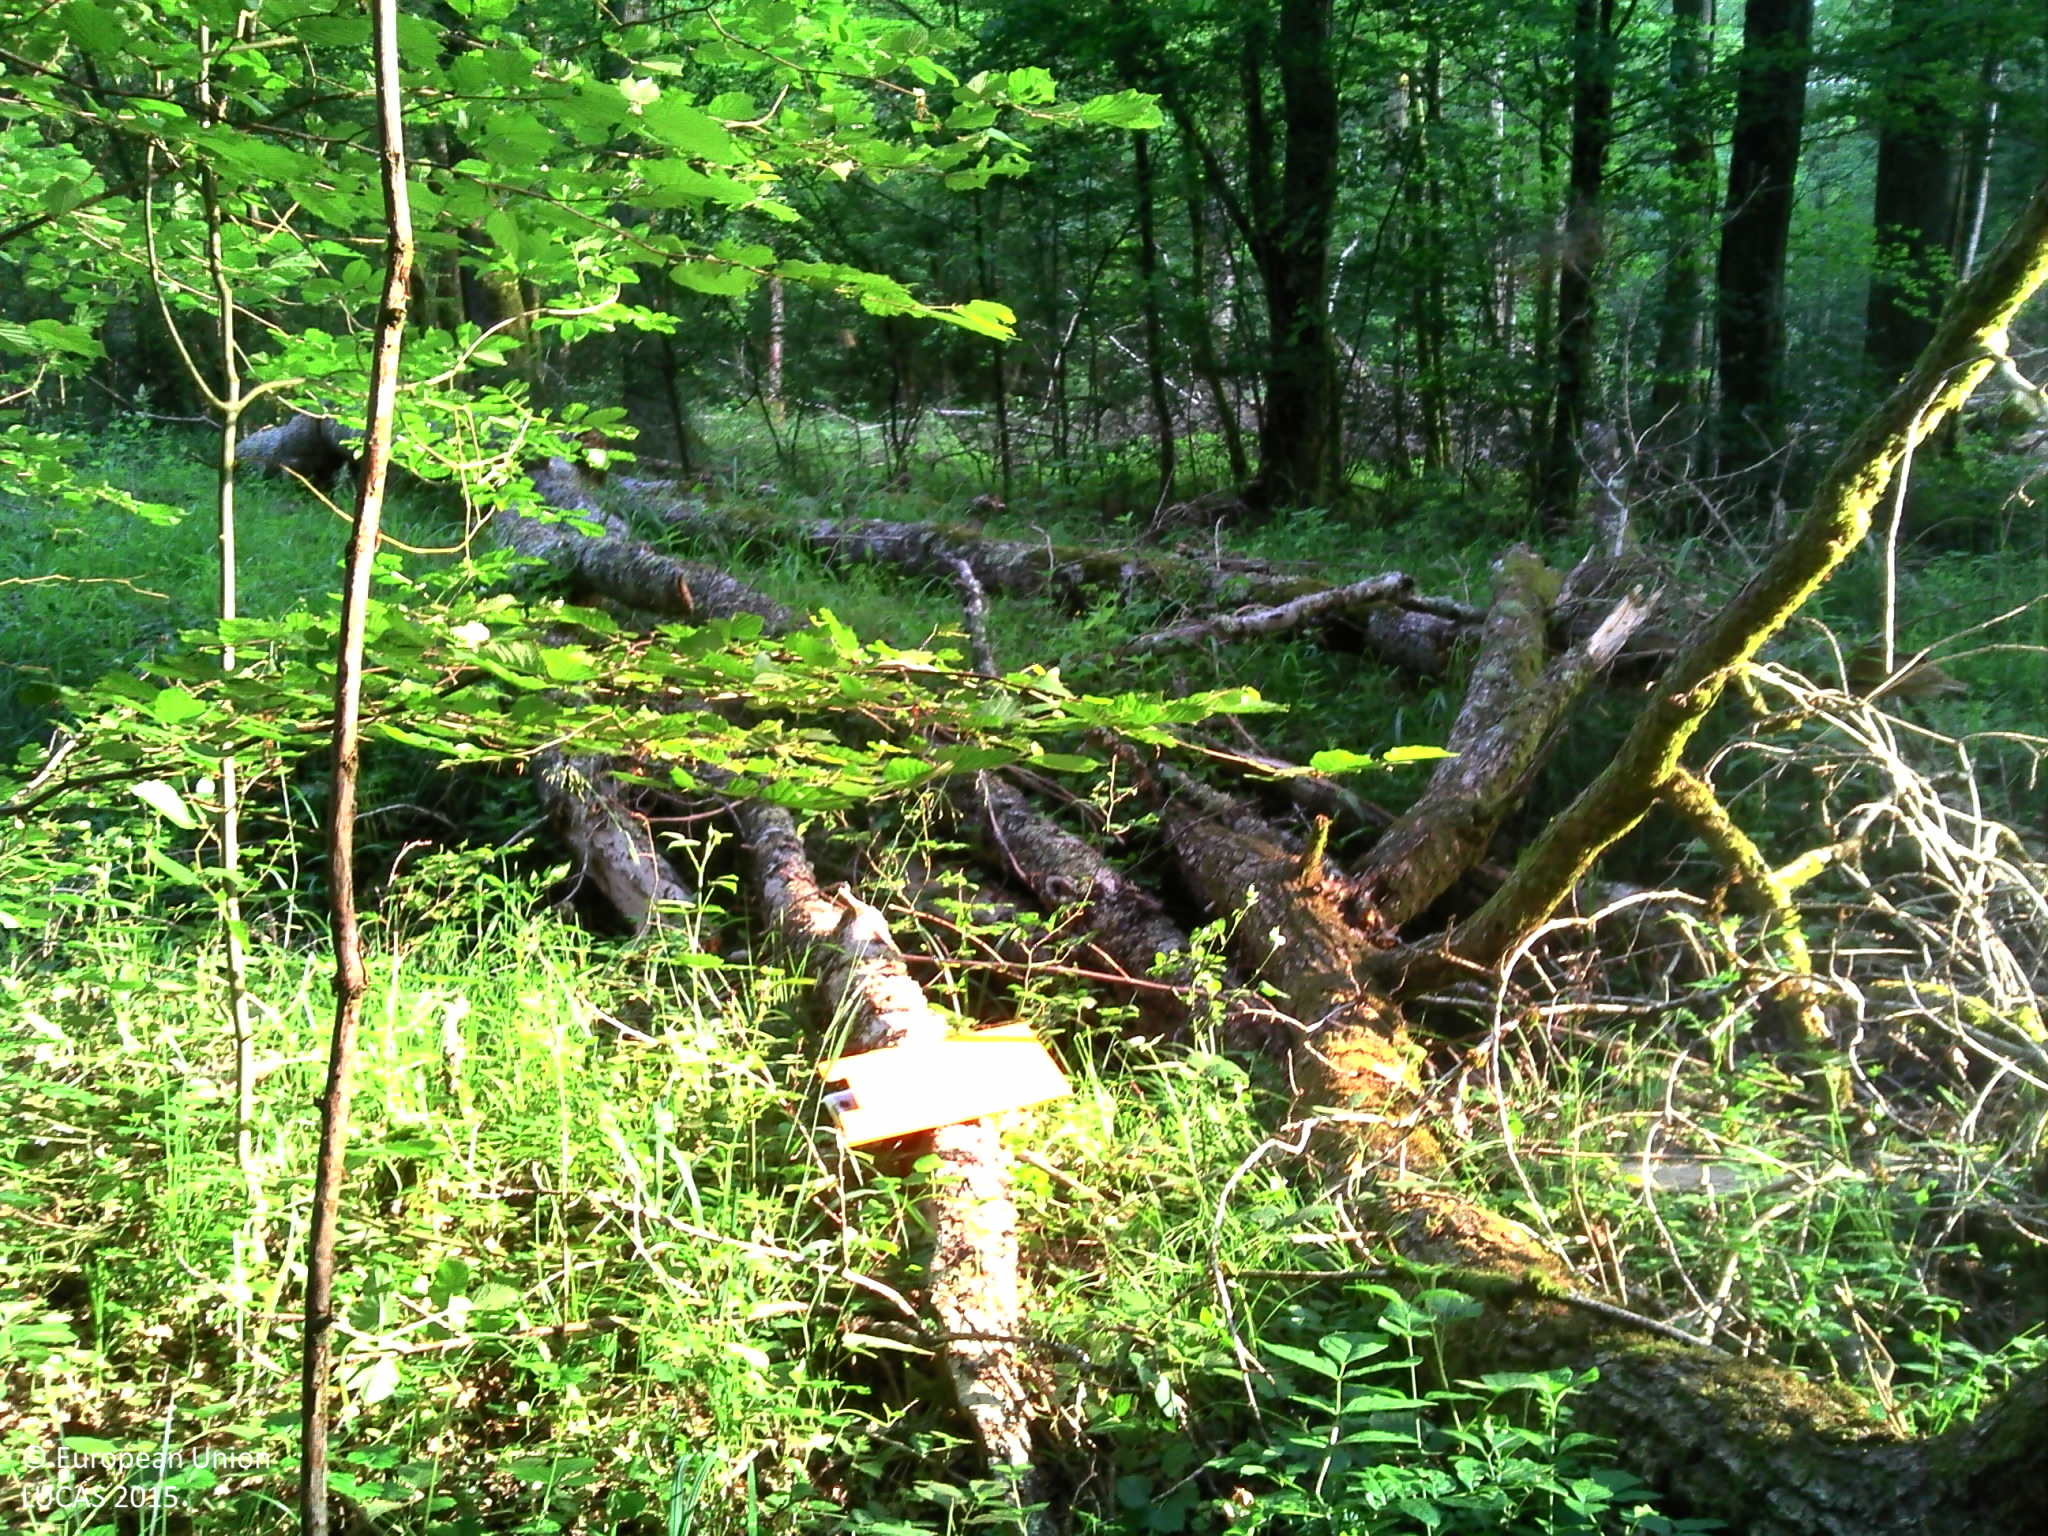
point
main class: Woodland
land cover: Broadleaved woodland
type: mesophytic deciduous forest
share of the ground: > 75 %
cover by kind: broadleaved forest trees 95 %, herbaceous plants 5 %
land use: Forestry
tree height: > 5 m
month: June
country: FR
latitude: 47.7958
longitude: 6.1428
